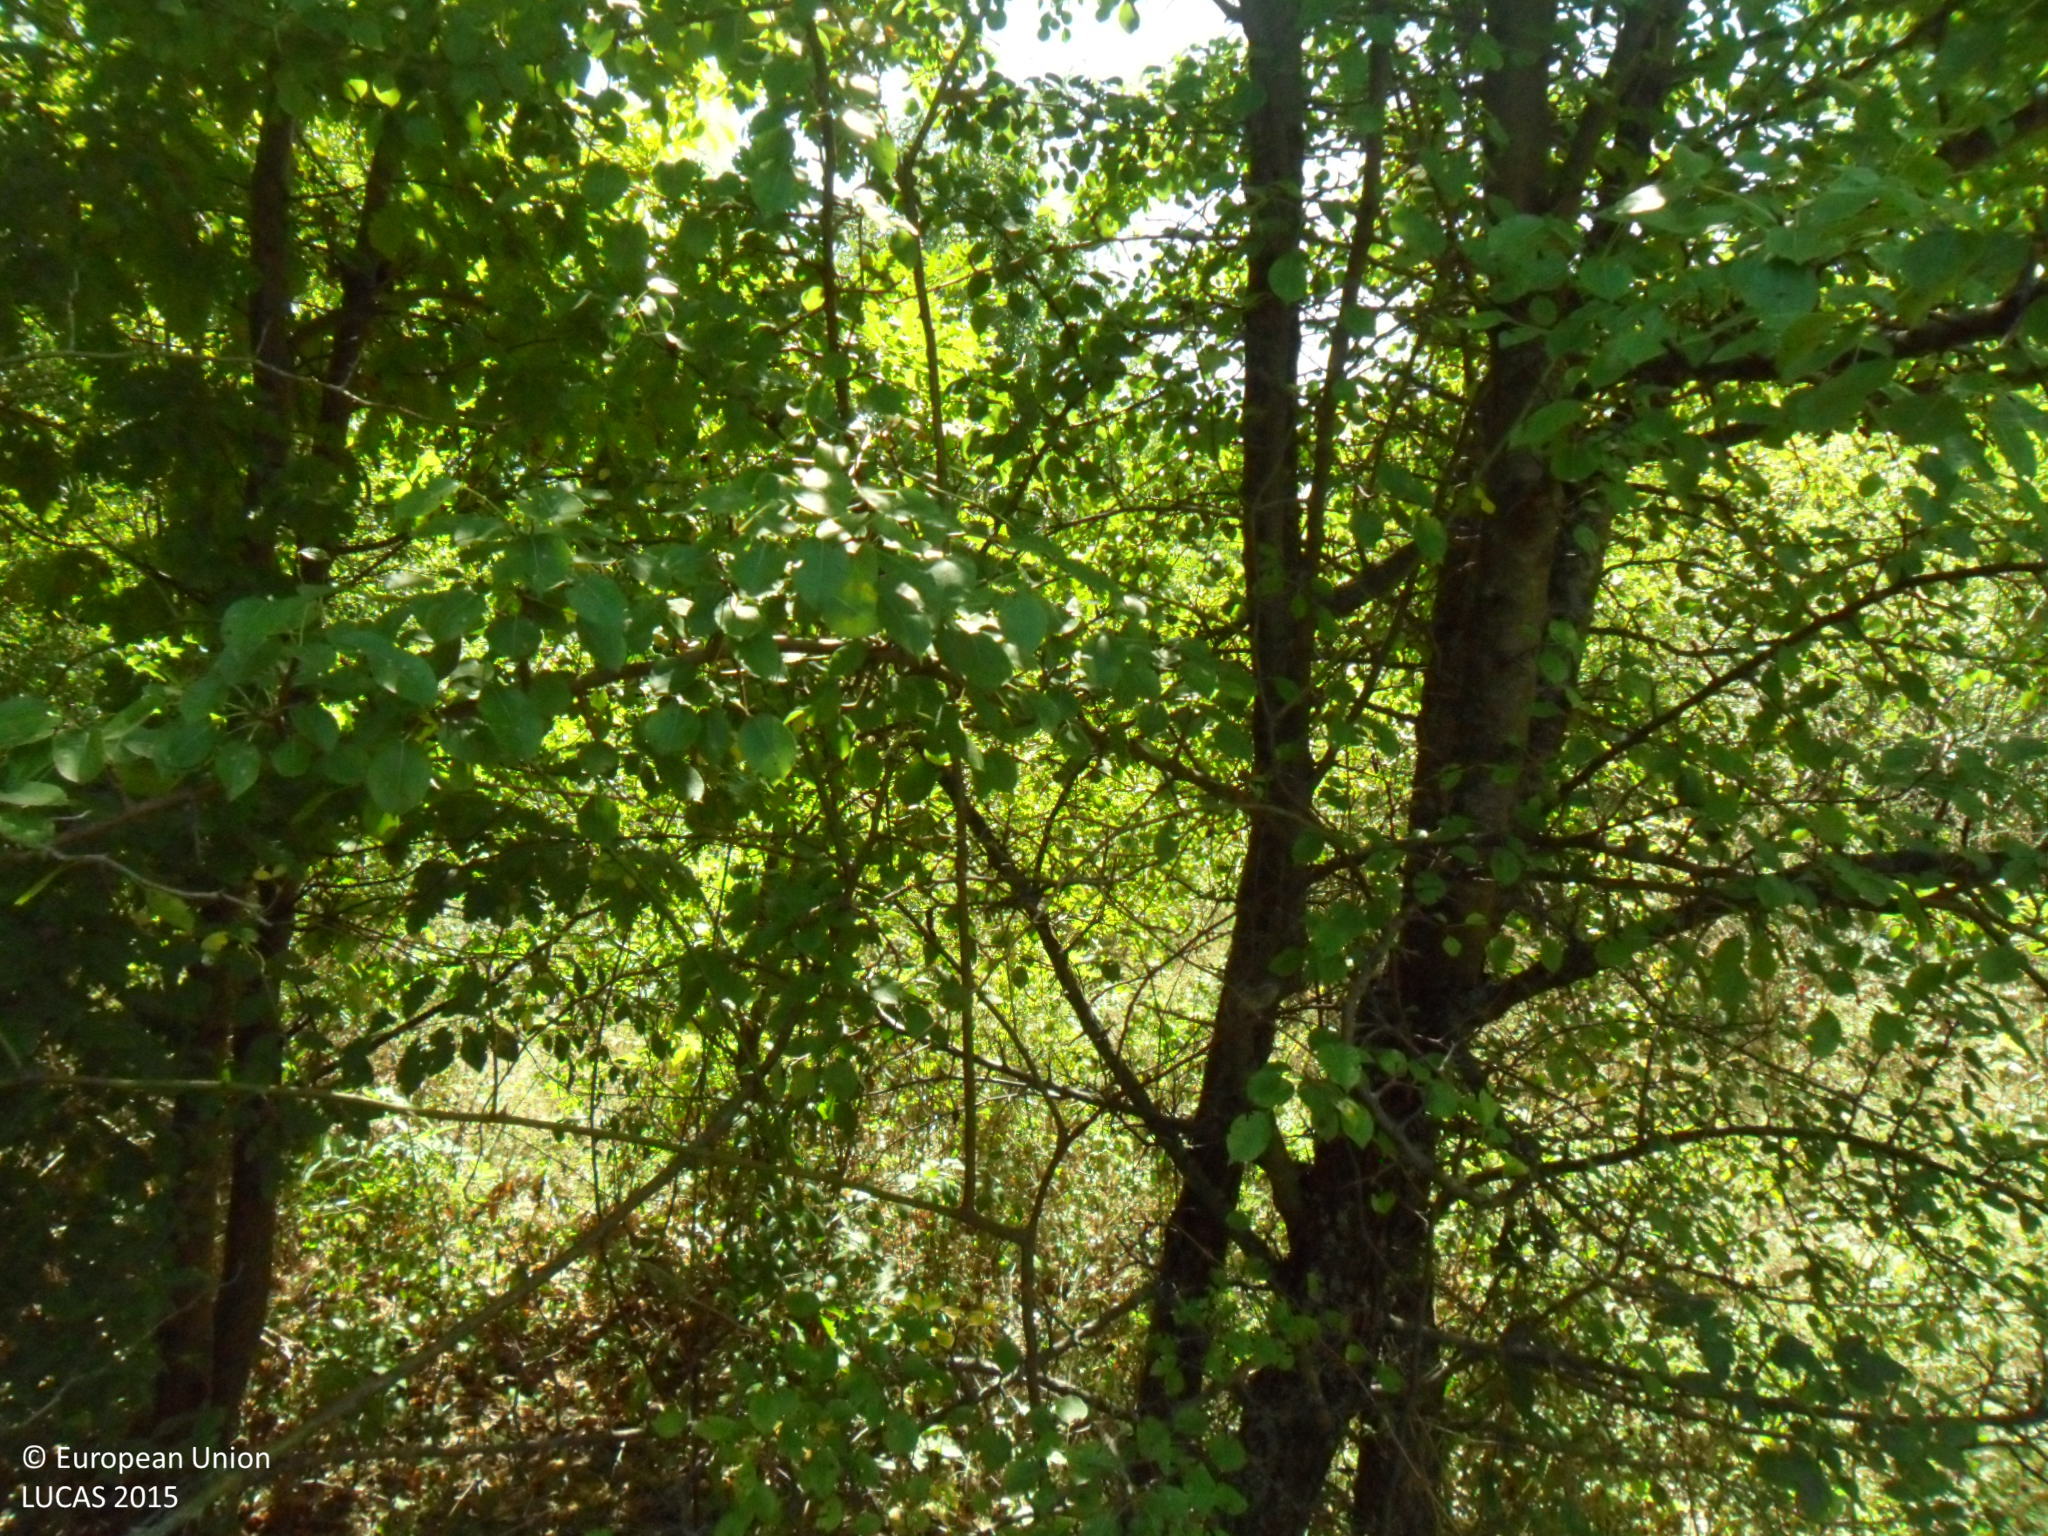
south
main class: Cropland
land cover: Nuts trees
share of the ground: > 75 %
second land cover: Shrubland without tree cover
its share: 50 - 75 %
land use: Agriculture (excluding fallow land and kitchen gardens)
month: September
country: BG
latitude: 43.6346
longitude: 27.2176
